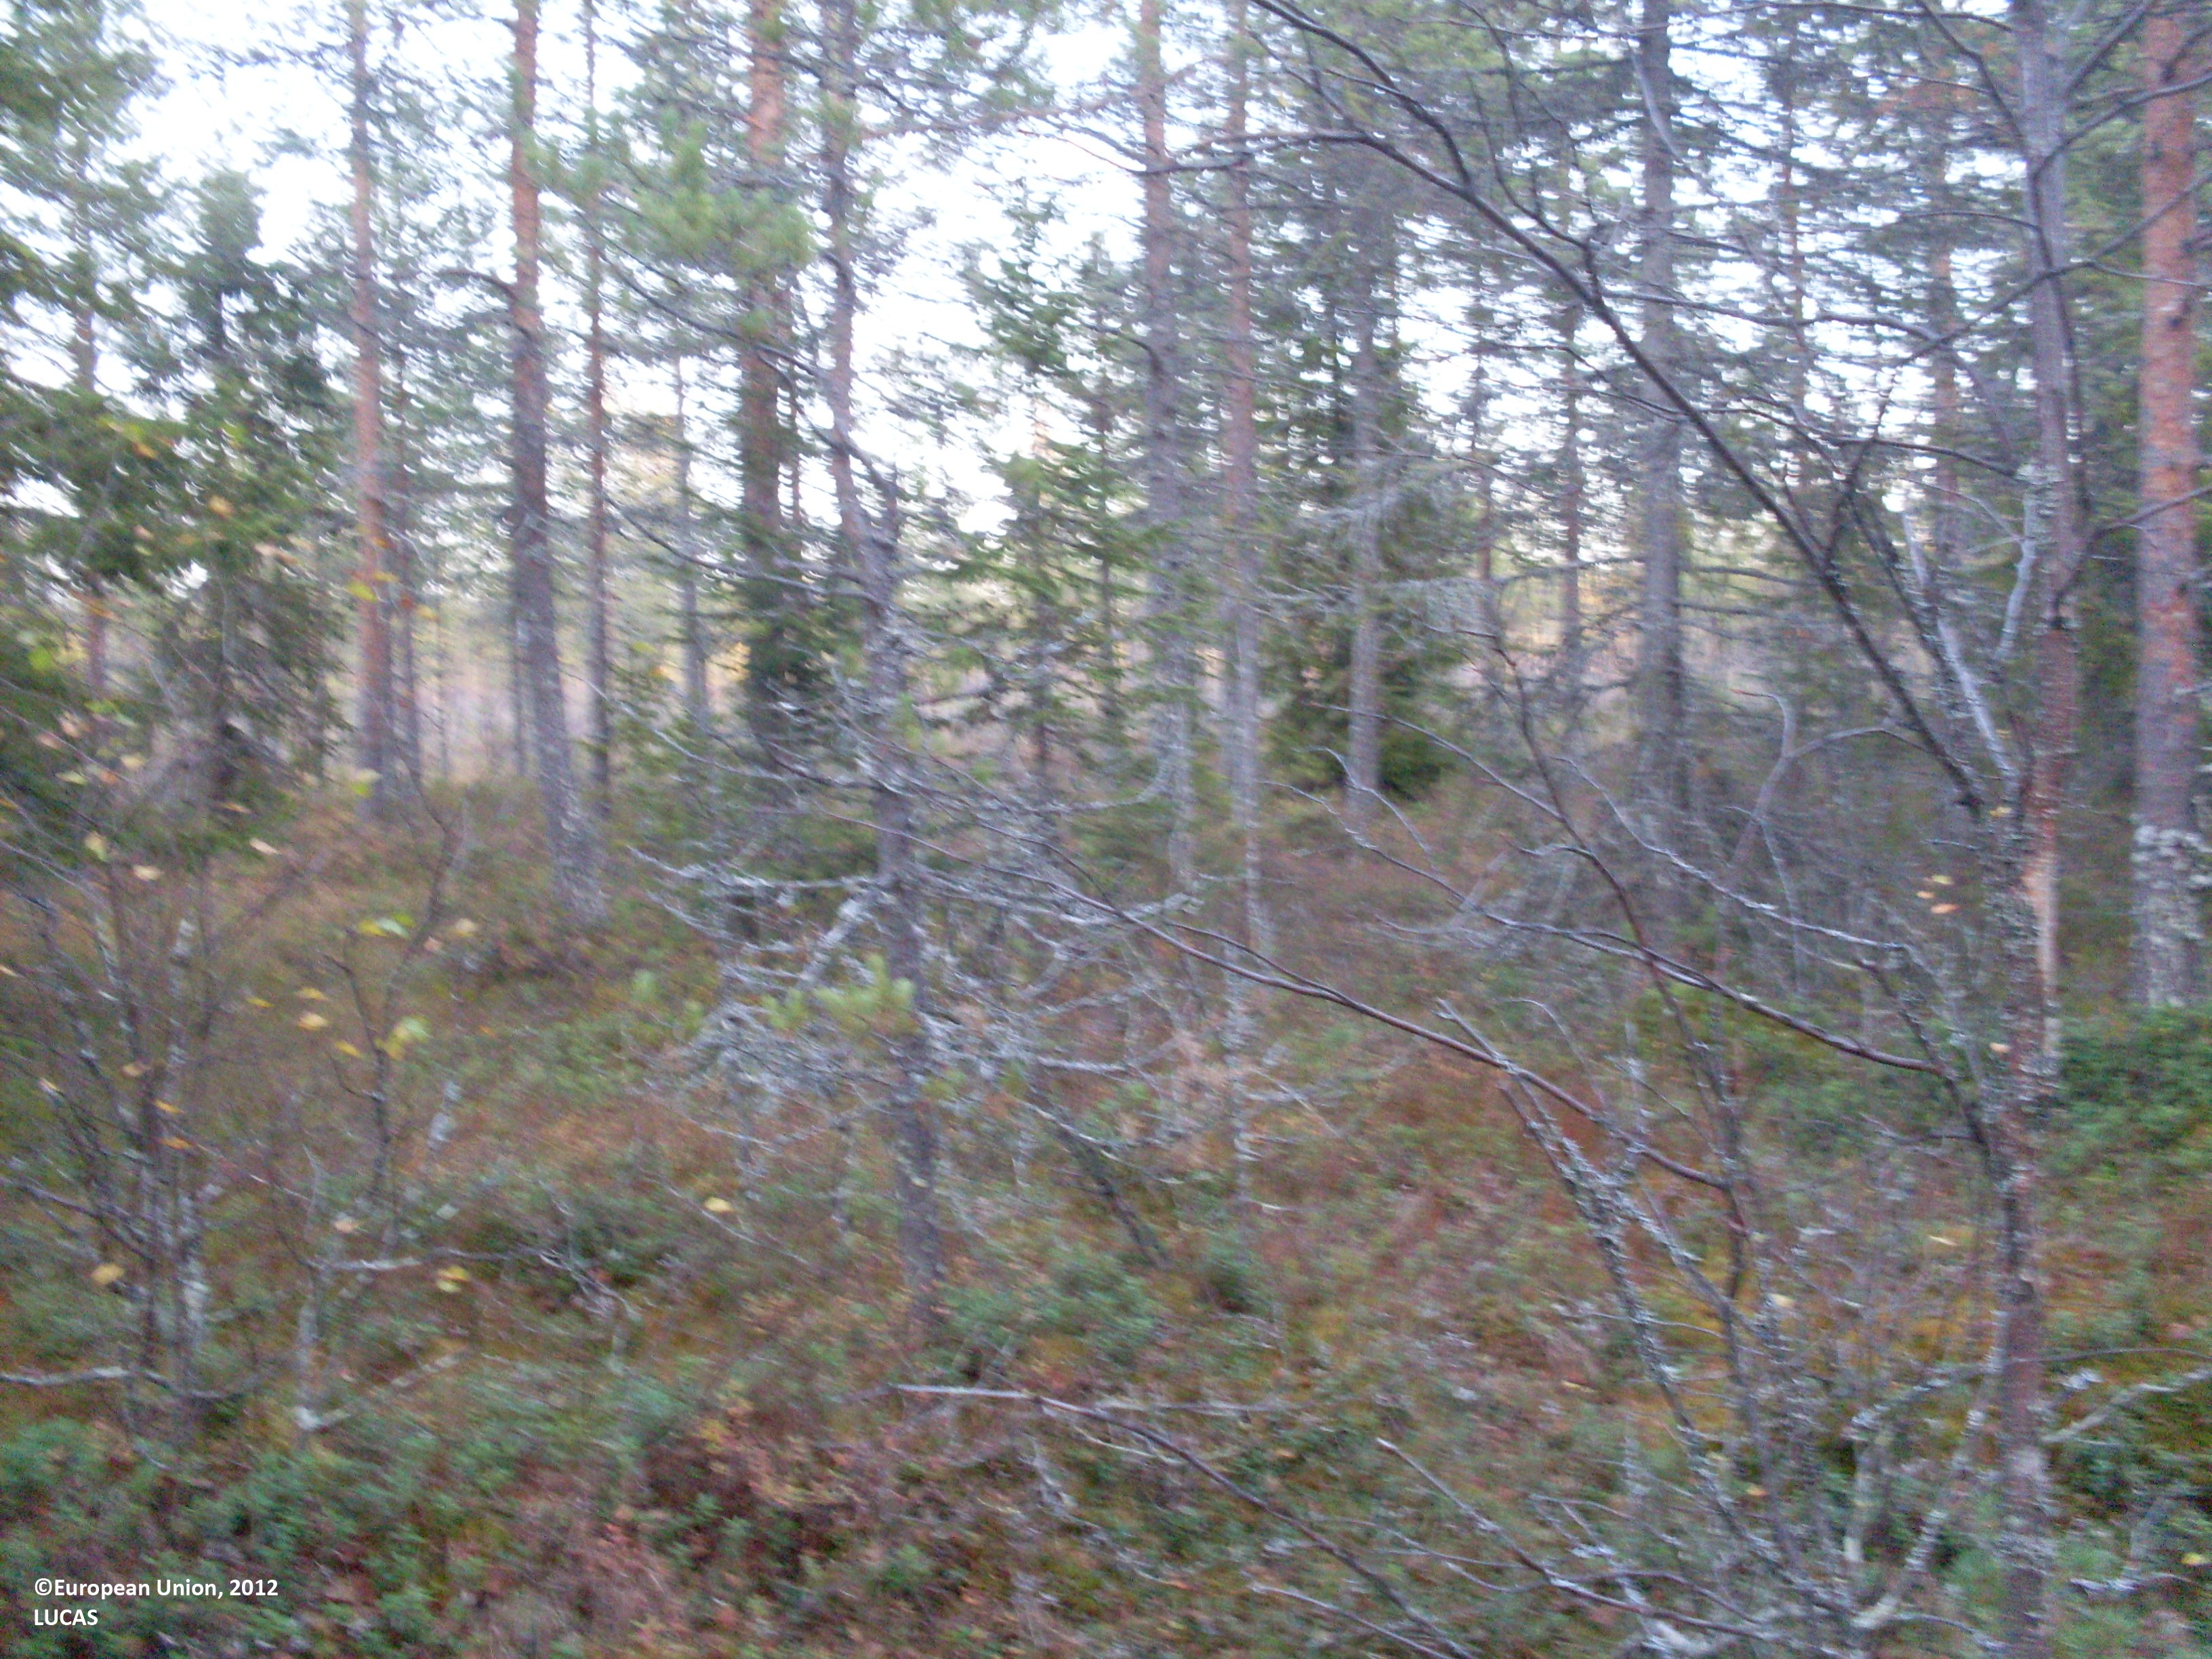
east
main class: Woodland
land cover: Pine dominated mixed woodland
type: boreal forest
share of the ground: 50 - 75 %
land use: Forestry
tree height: > 5 m
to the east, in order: Pine dominated mixed woodland; Ditches and canals; Pine dominated mixed woodland; Ditches and canals; Pine dominated coniferous woodland; Peatbogs; Ditches and canals; Peatbogs; Pine dominated mixed woodland; Ditches and canals; Pine dominated mixed woodland
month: September
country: FI
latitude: 64.6180
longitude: 29.5979
